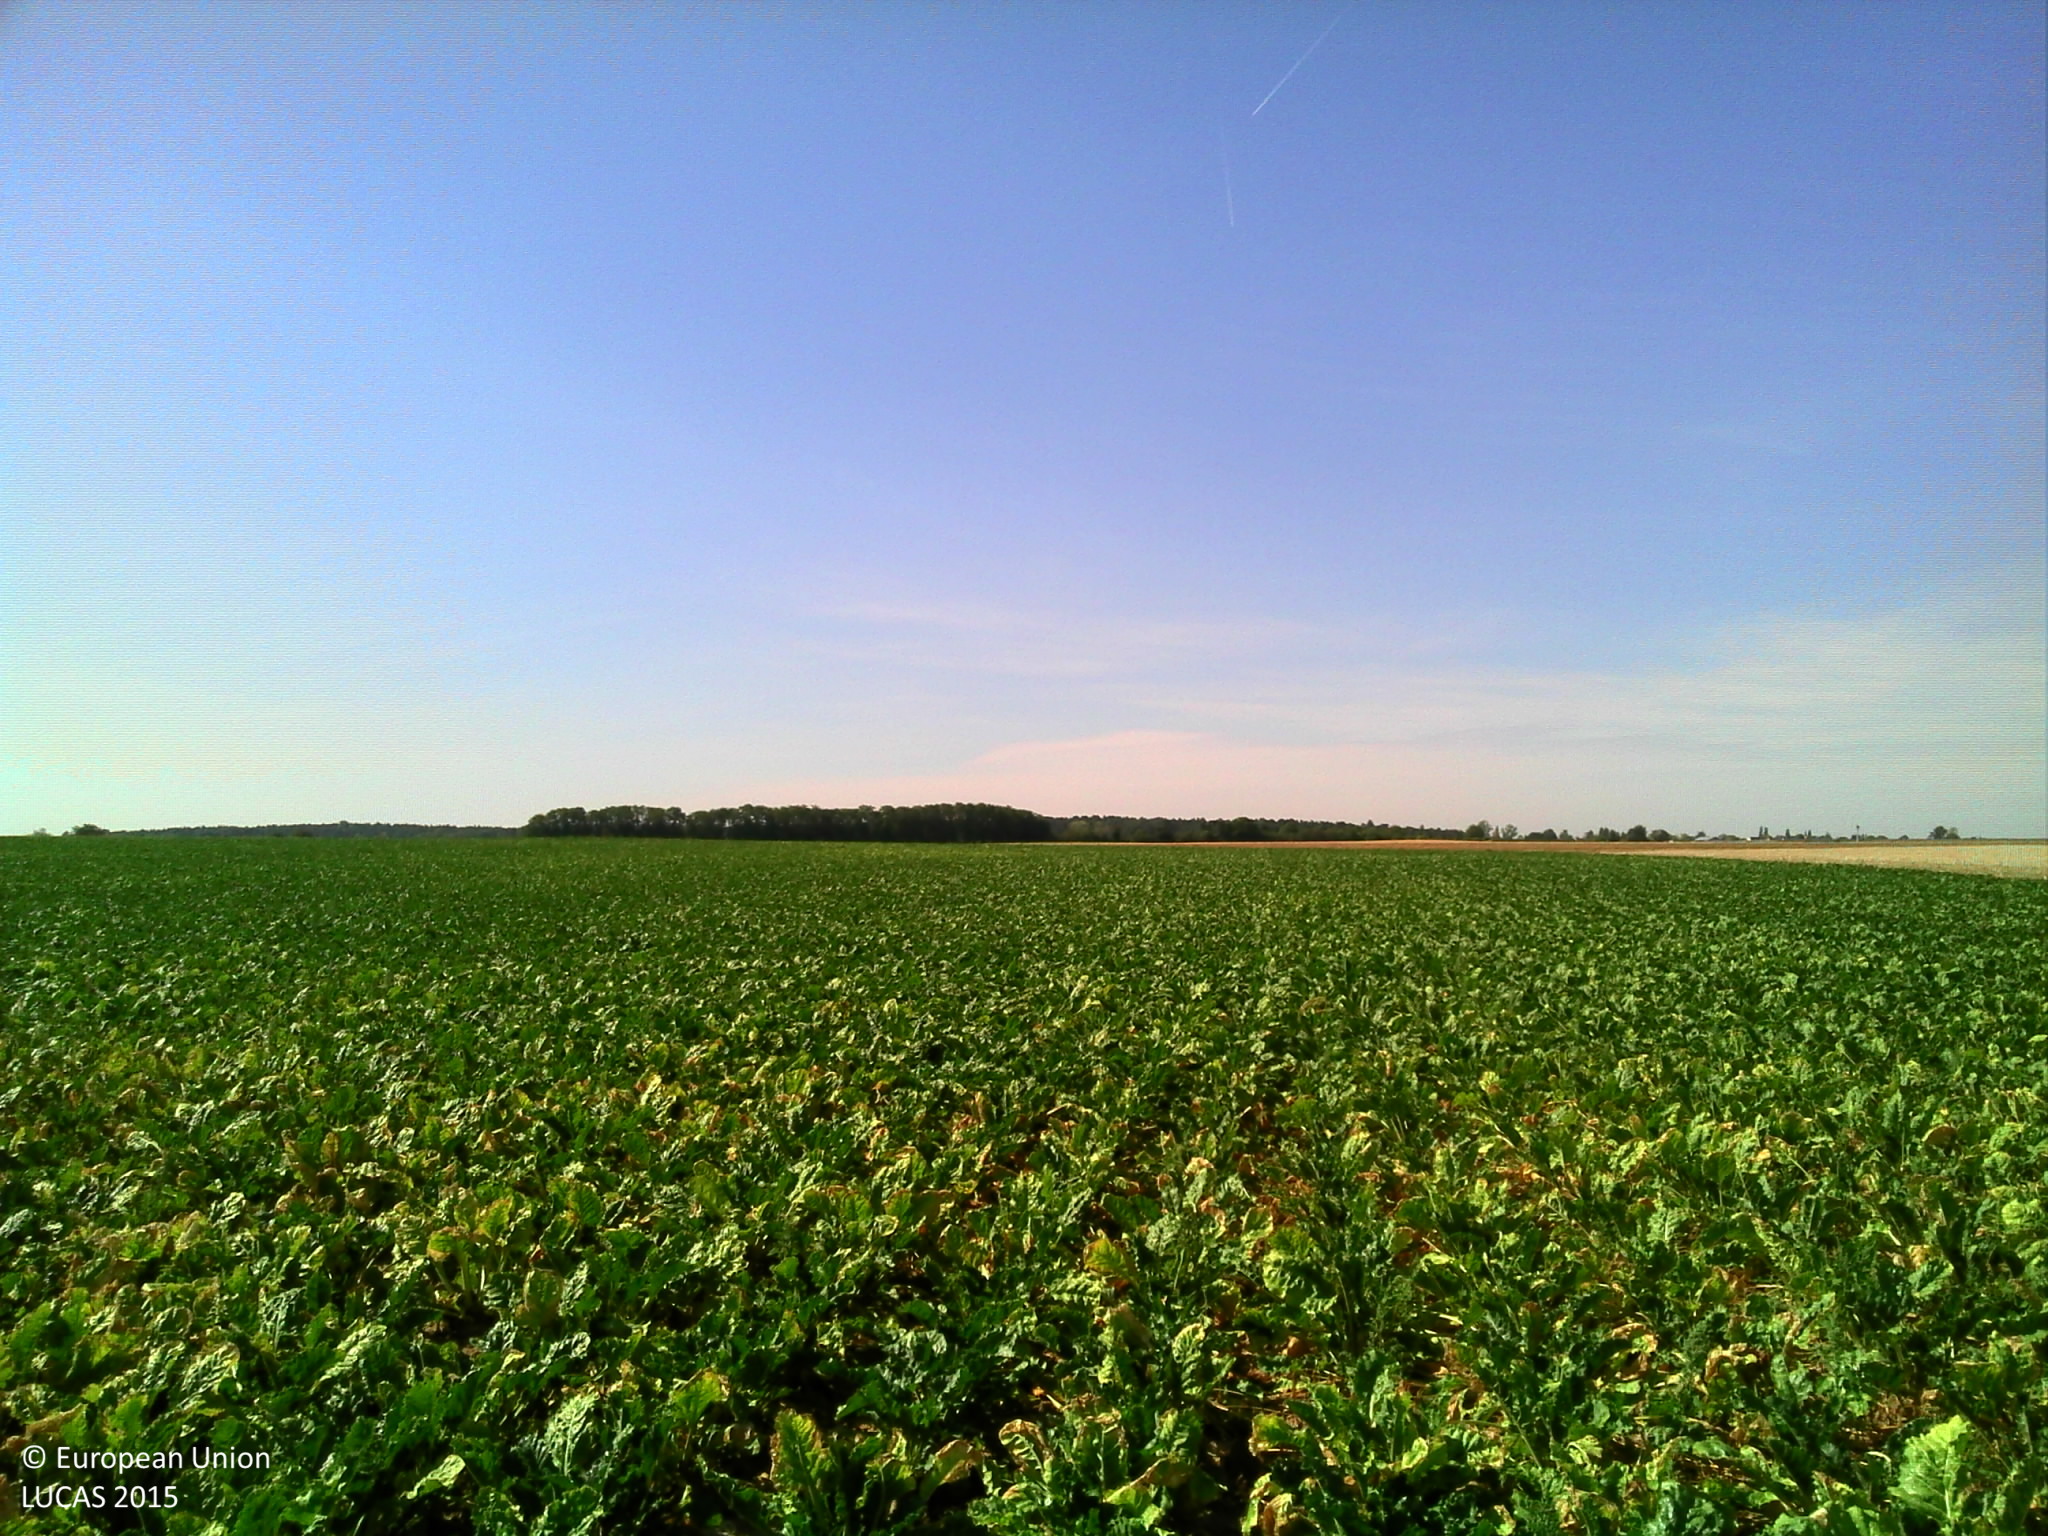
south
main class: Cropland
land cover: Sugar beet
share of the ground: > 75 %
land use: Agriculture (excluding fallow land and kitchen gardens)
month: August
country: FR
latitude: 48.3368
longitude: 2.6110
